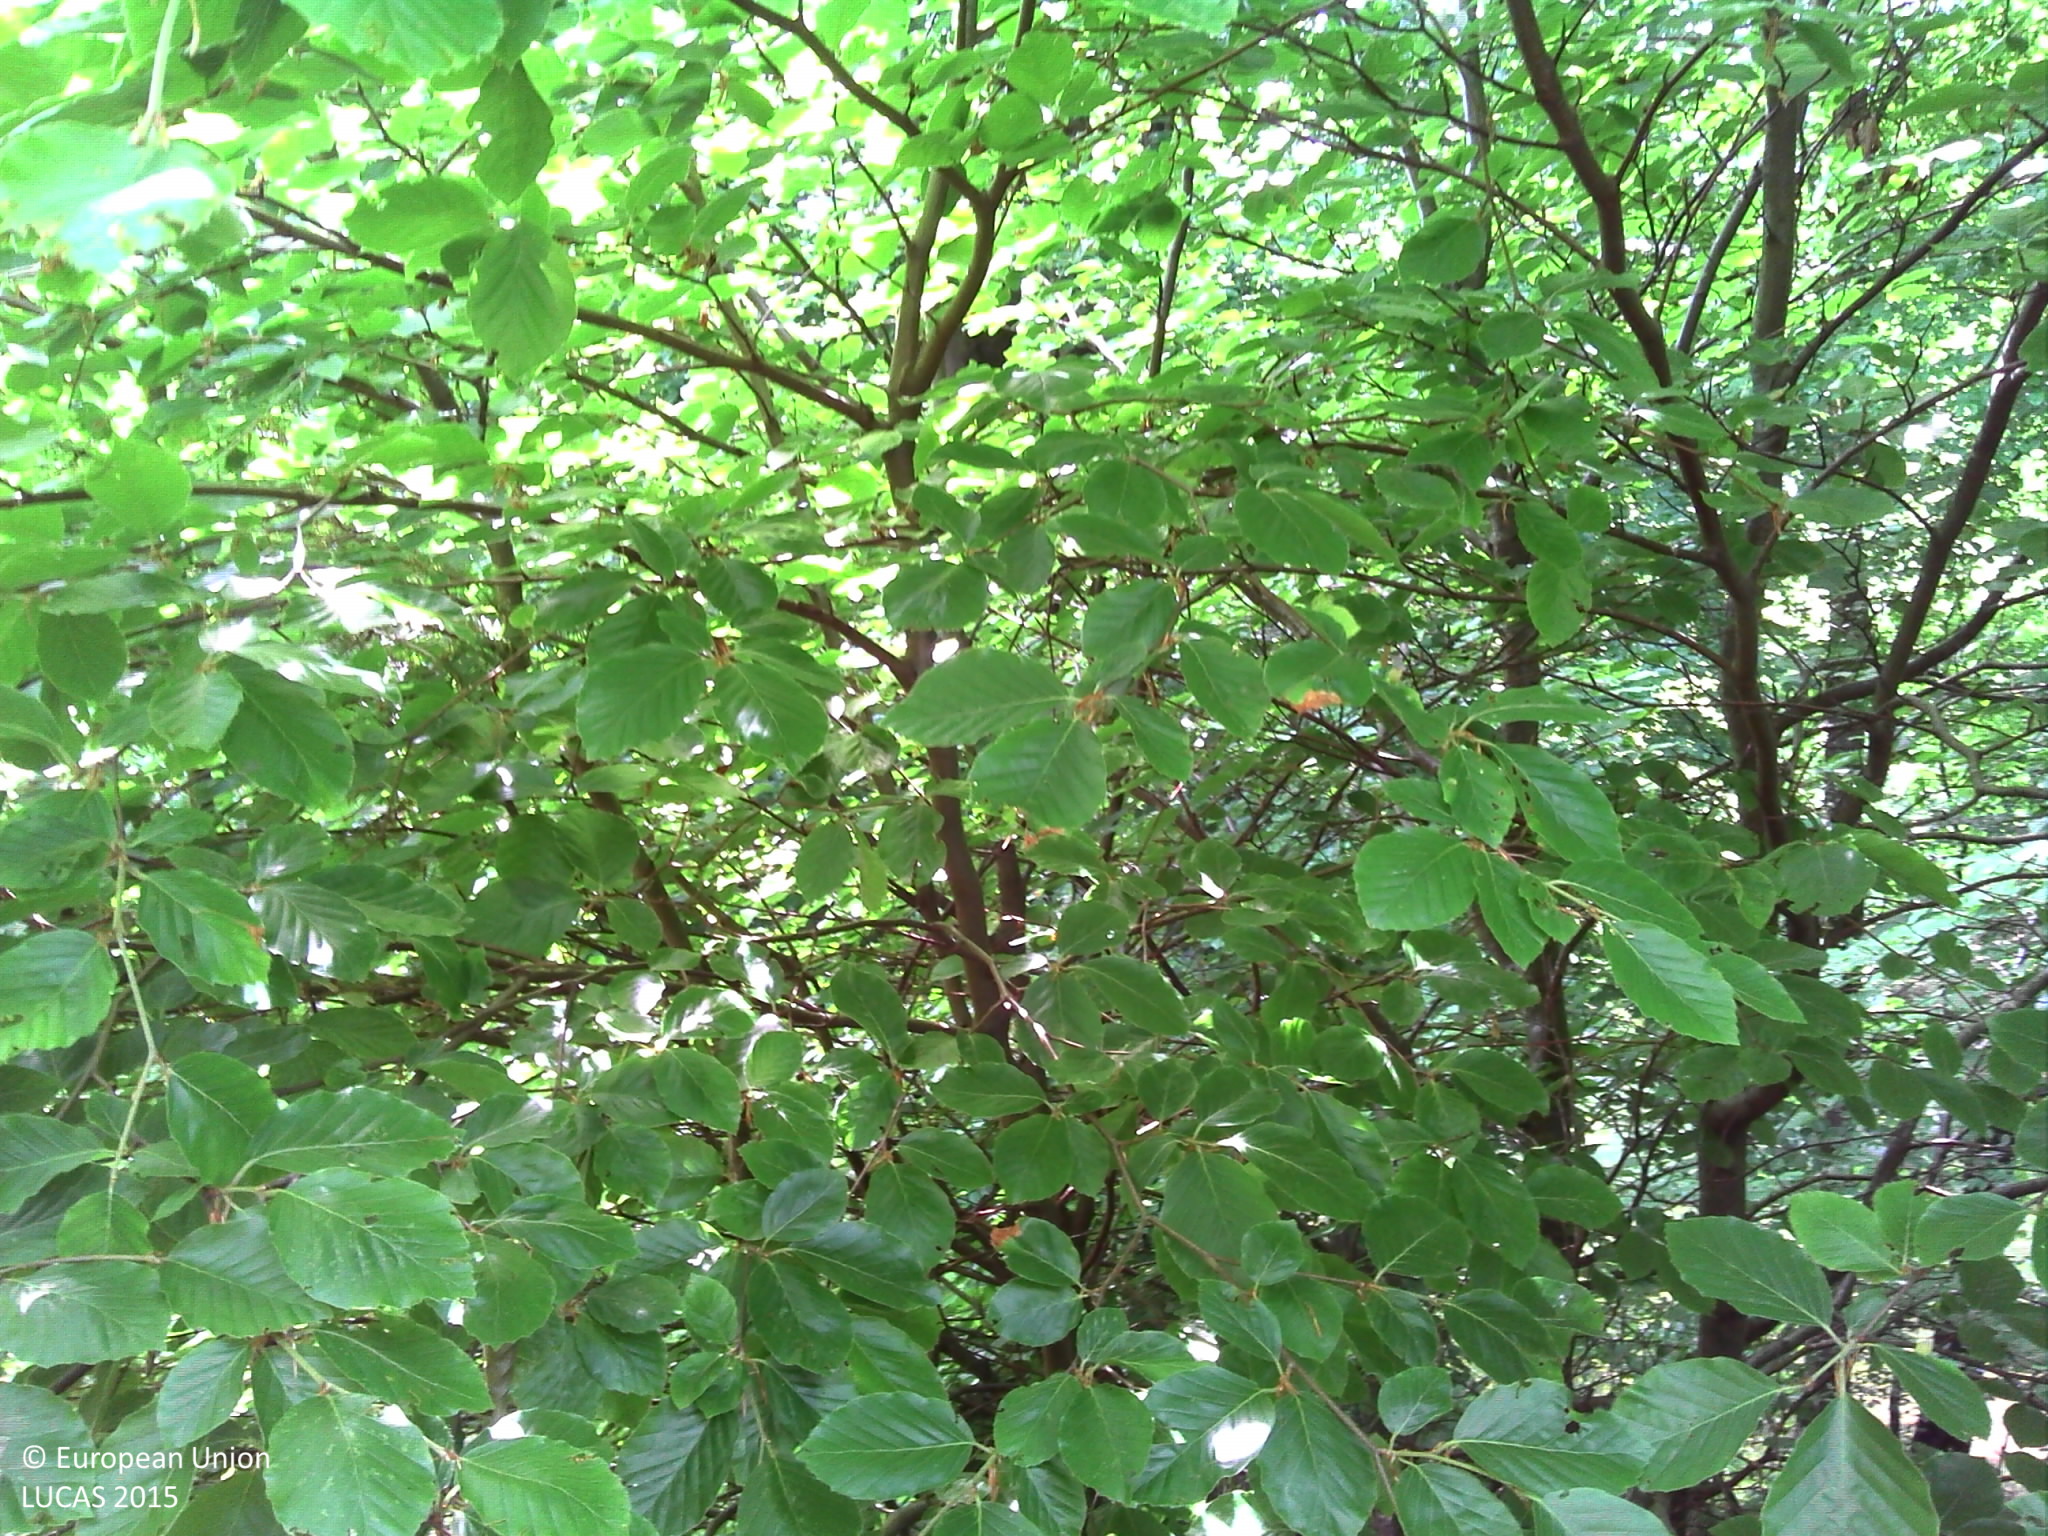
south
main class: Woodland
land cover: Other coniferous woodland
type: exotic forest
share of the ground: > 75 %
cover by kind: coniferous forest trees 90 %, broadleaved forest trees 5 %, shrubs 5 %
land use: Forestry
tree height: > 5 m
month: June
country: BE
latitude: 50.0319
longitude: 5.2653
